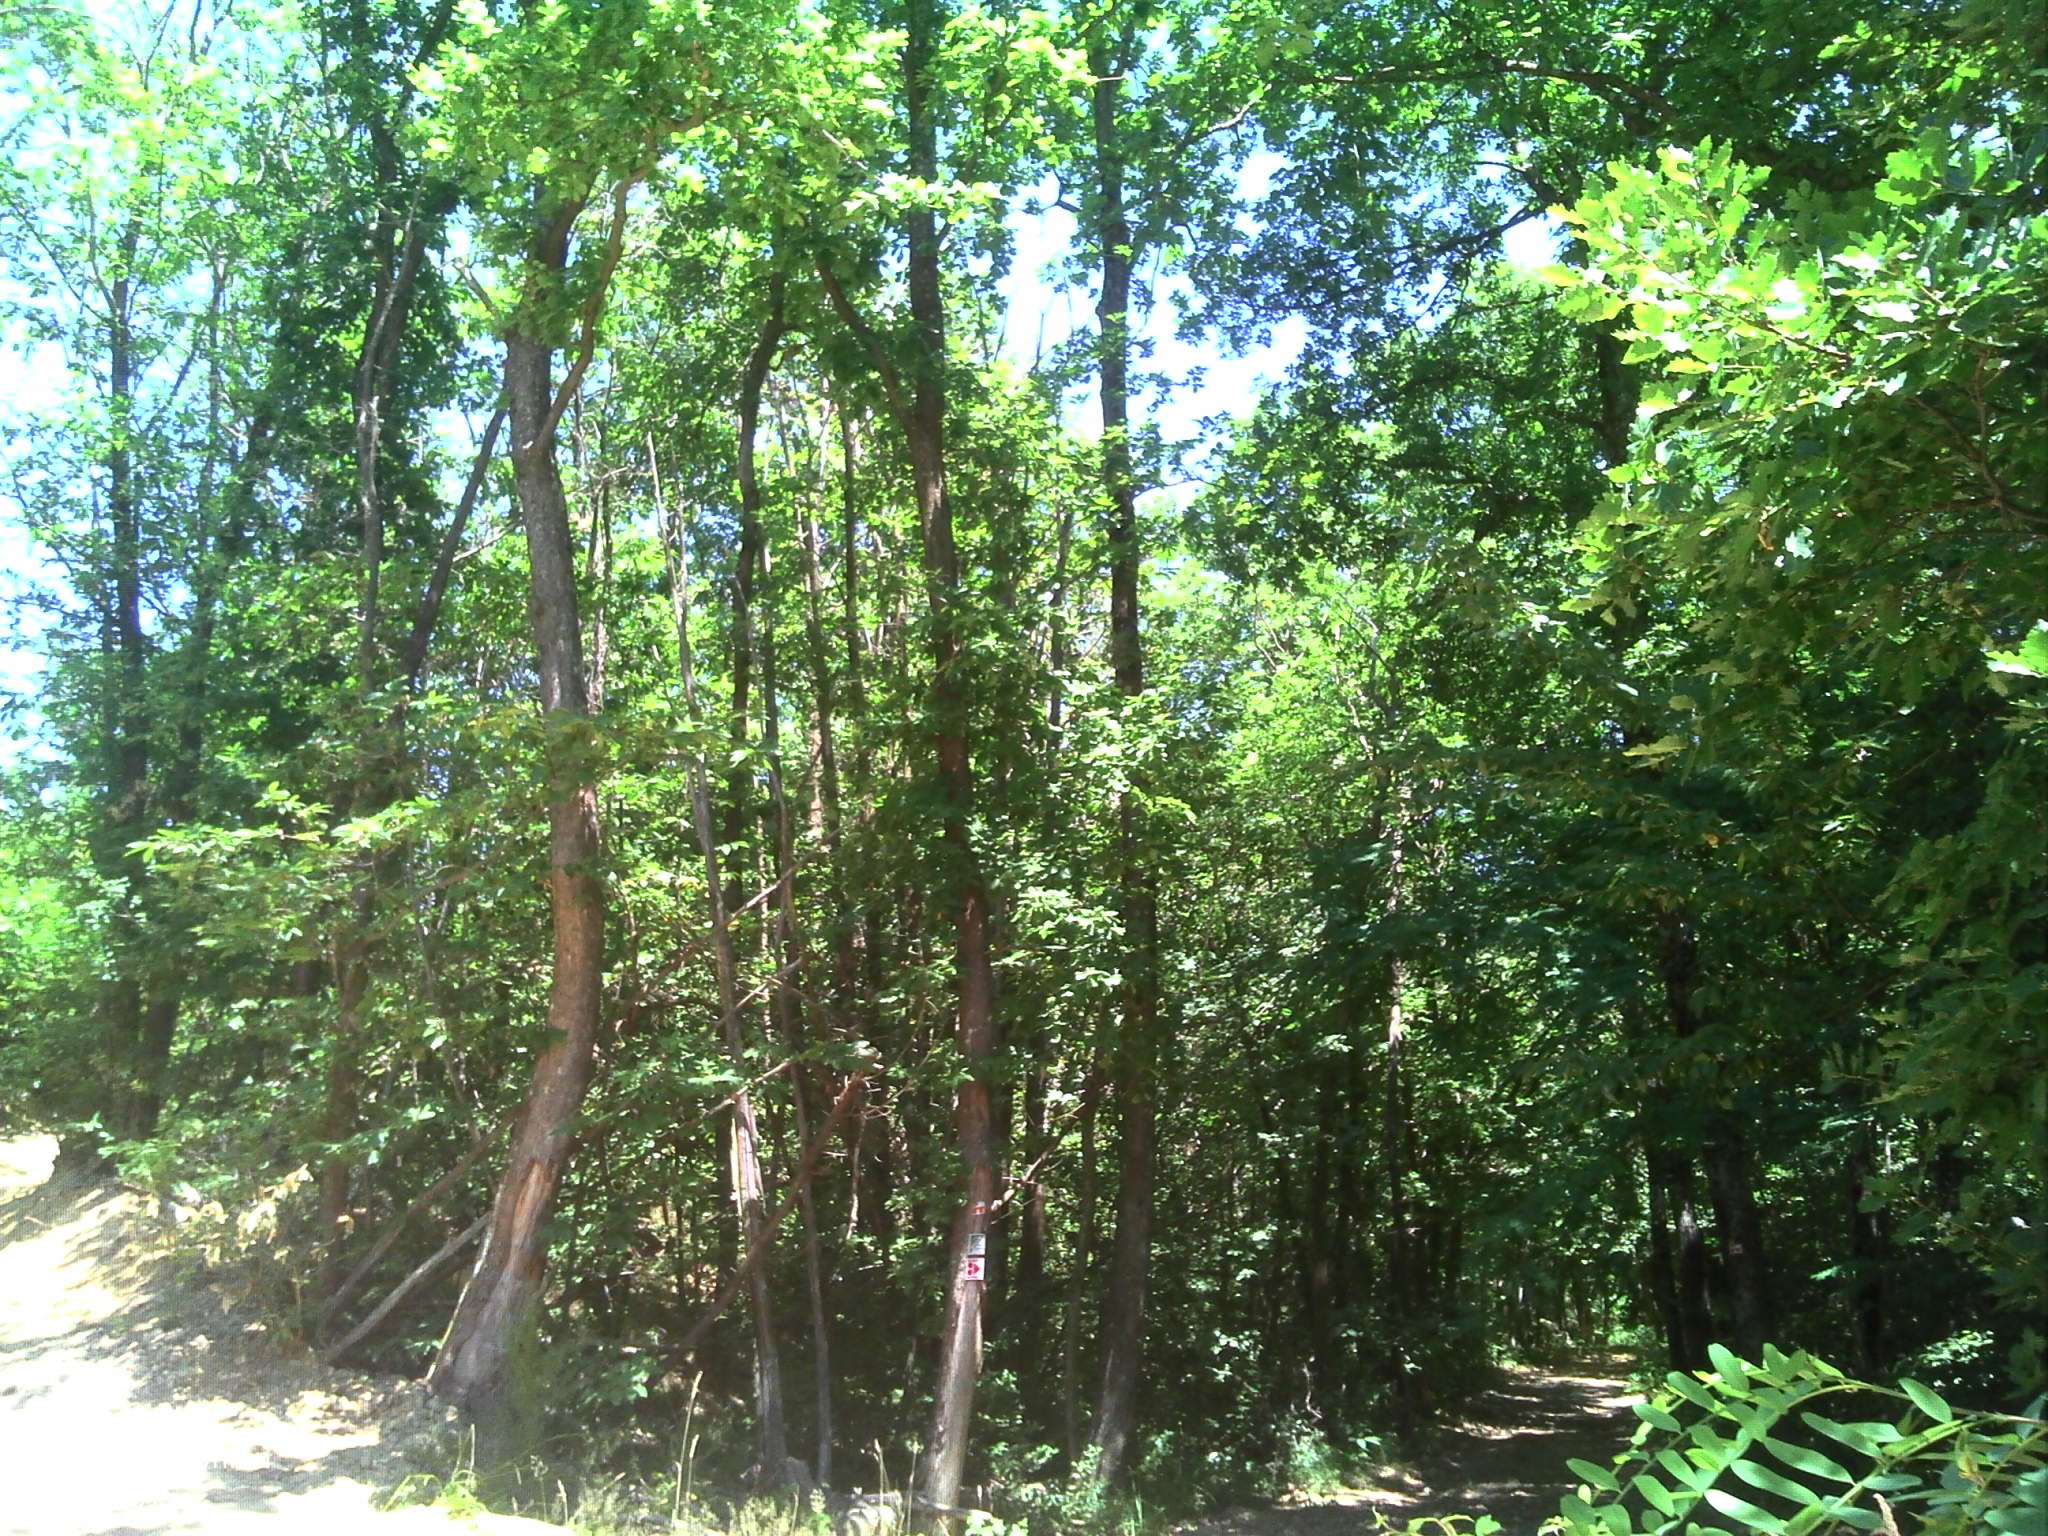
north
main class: Woodland
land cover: Broadleaved woodland
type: mesophytic deciduous forest
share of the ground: > 75 %
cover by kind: broadleaved forest trees 100 %
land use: Forestry
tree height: > 5 m
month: July
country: FR
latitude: 45.1598
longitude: 5.1839
